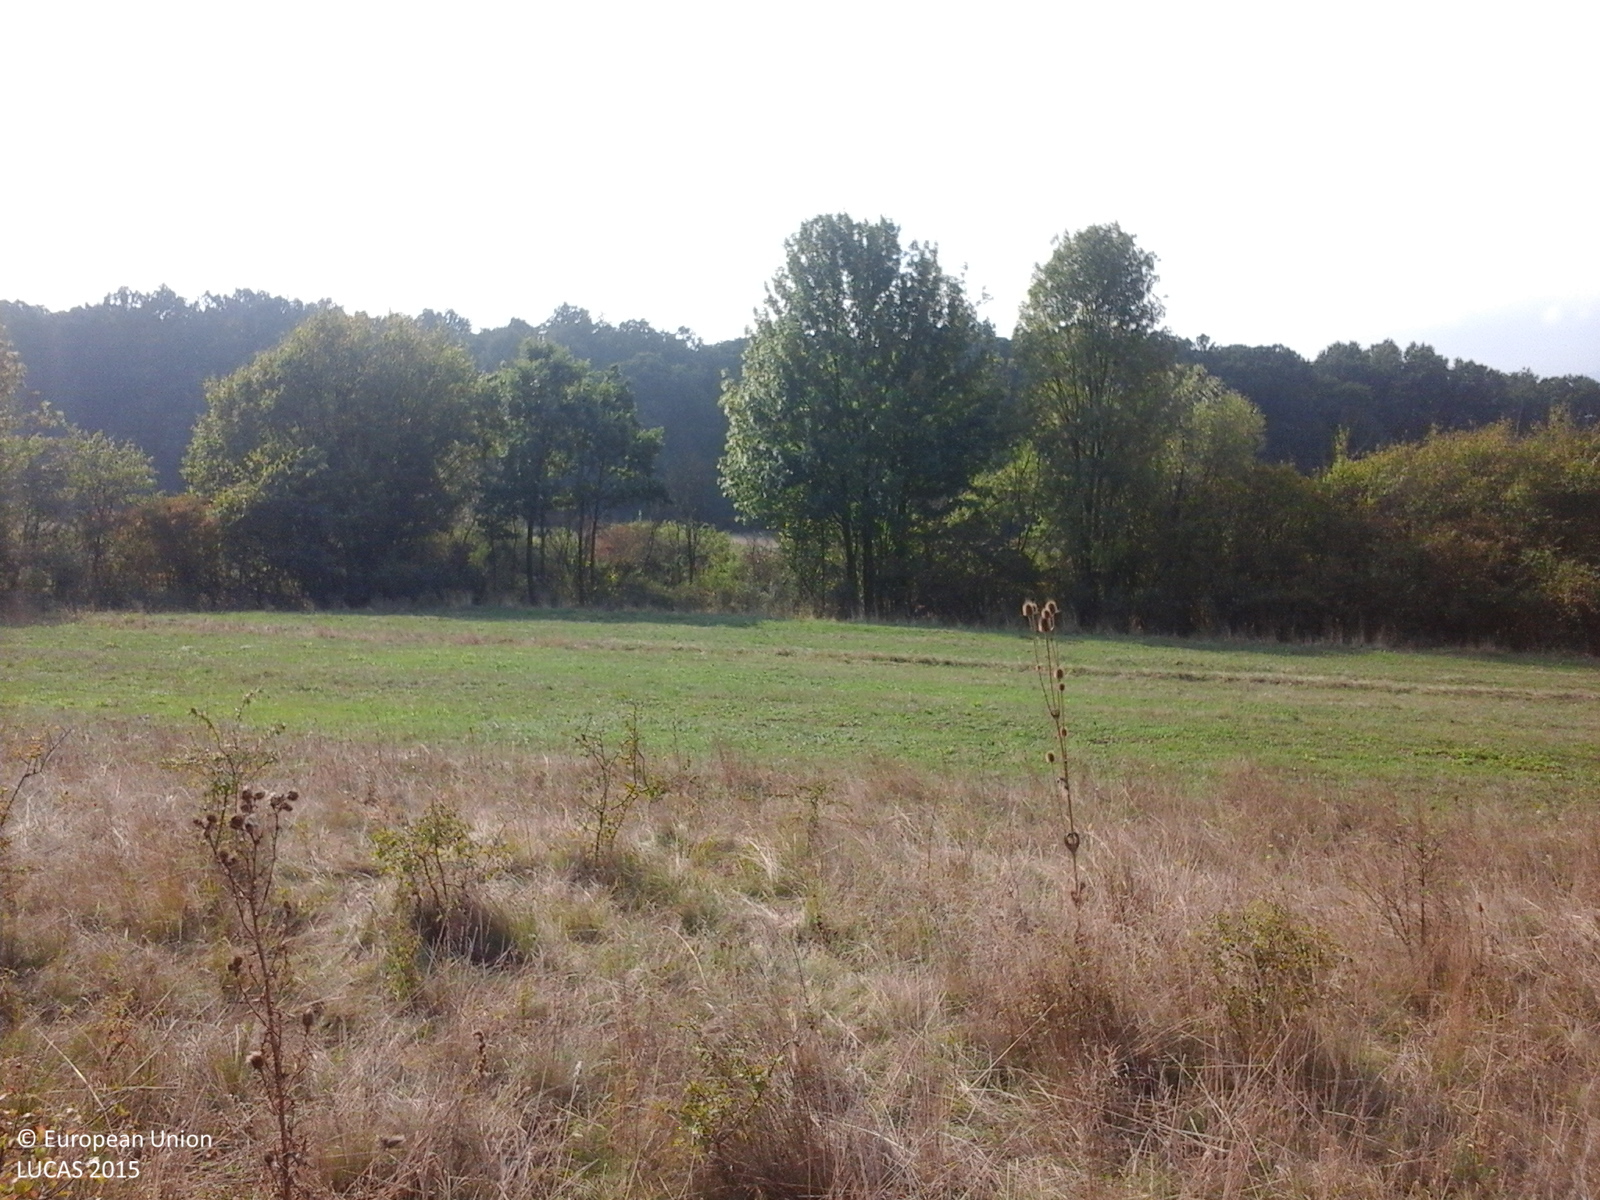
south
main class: Grassland
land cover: Grassland with sparse tree/shrub cover
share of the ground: > 75 %
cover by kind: herbaceous plants 85 %, shrubs 10 %, broadleaved forest trees 5 %
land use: Fallow land
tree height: < 5 m
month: September
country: RO
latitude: 45.9449
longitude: 22.7844
